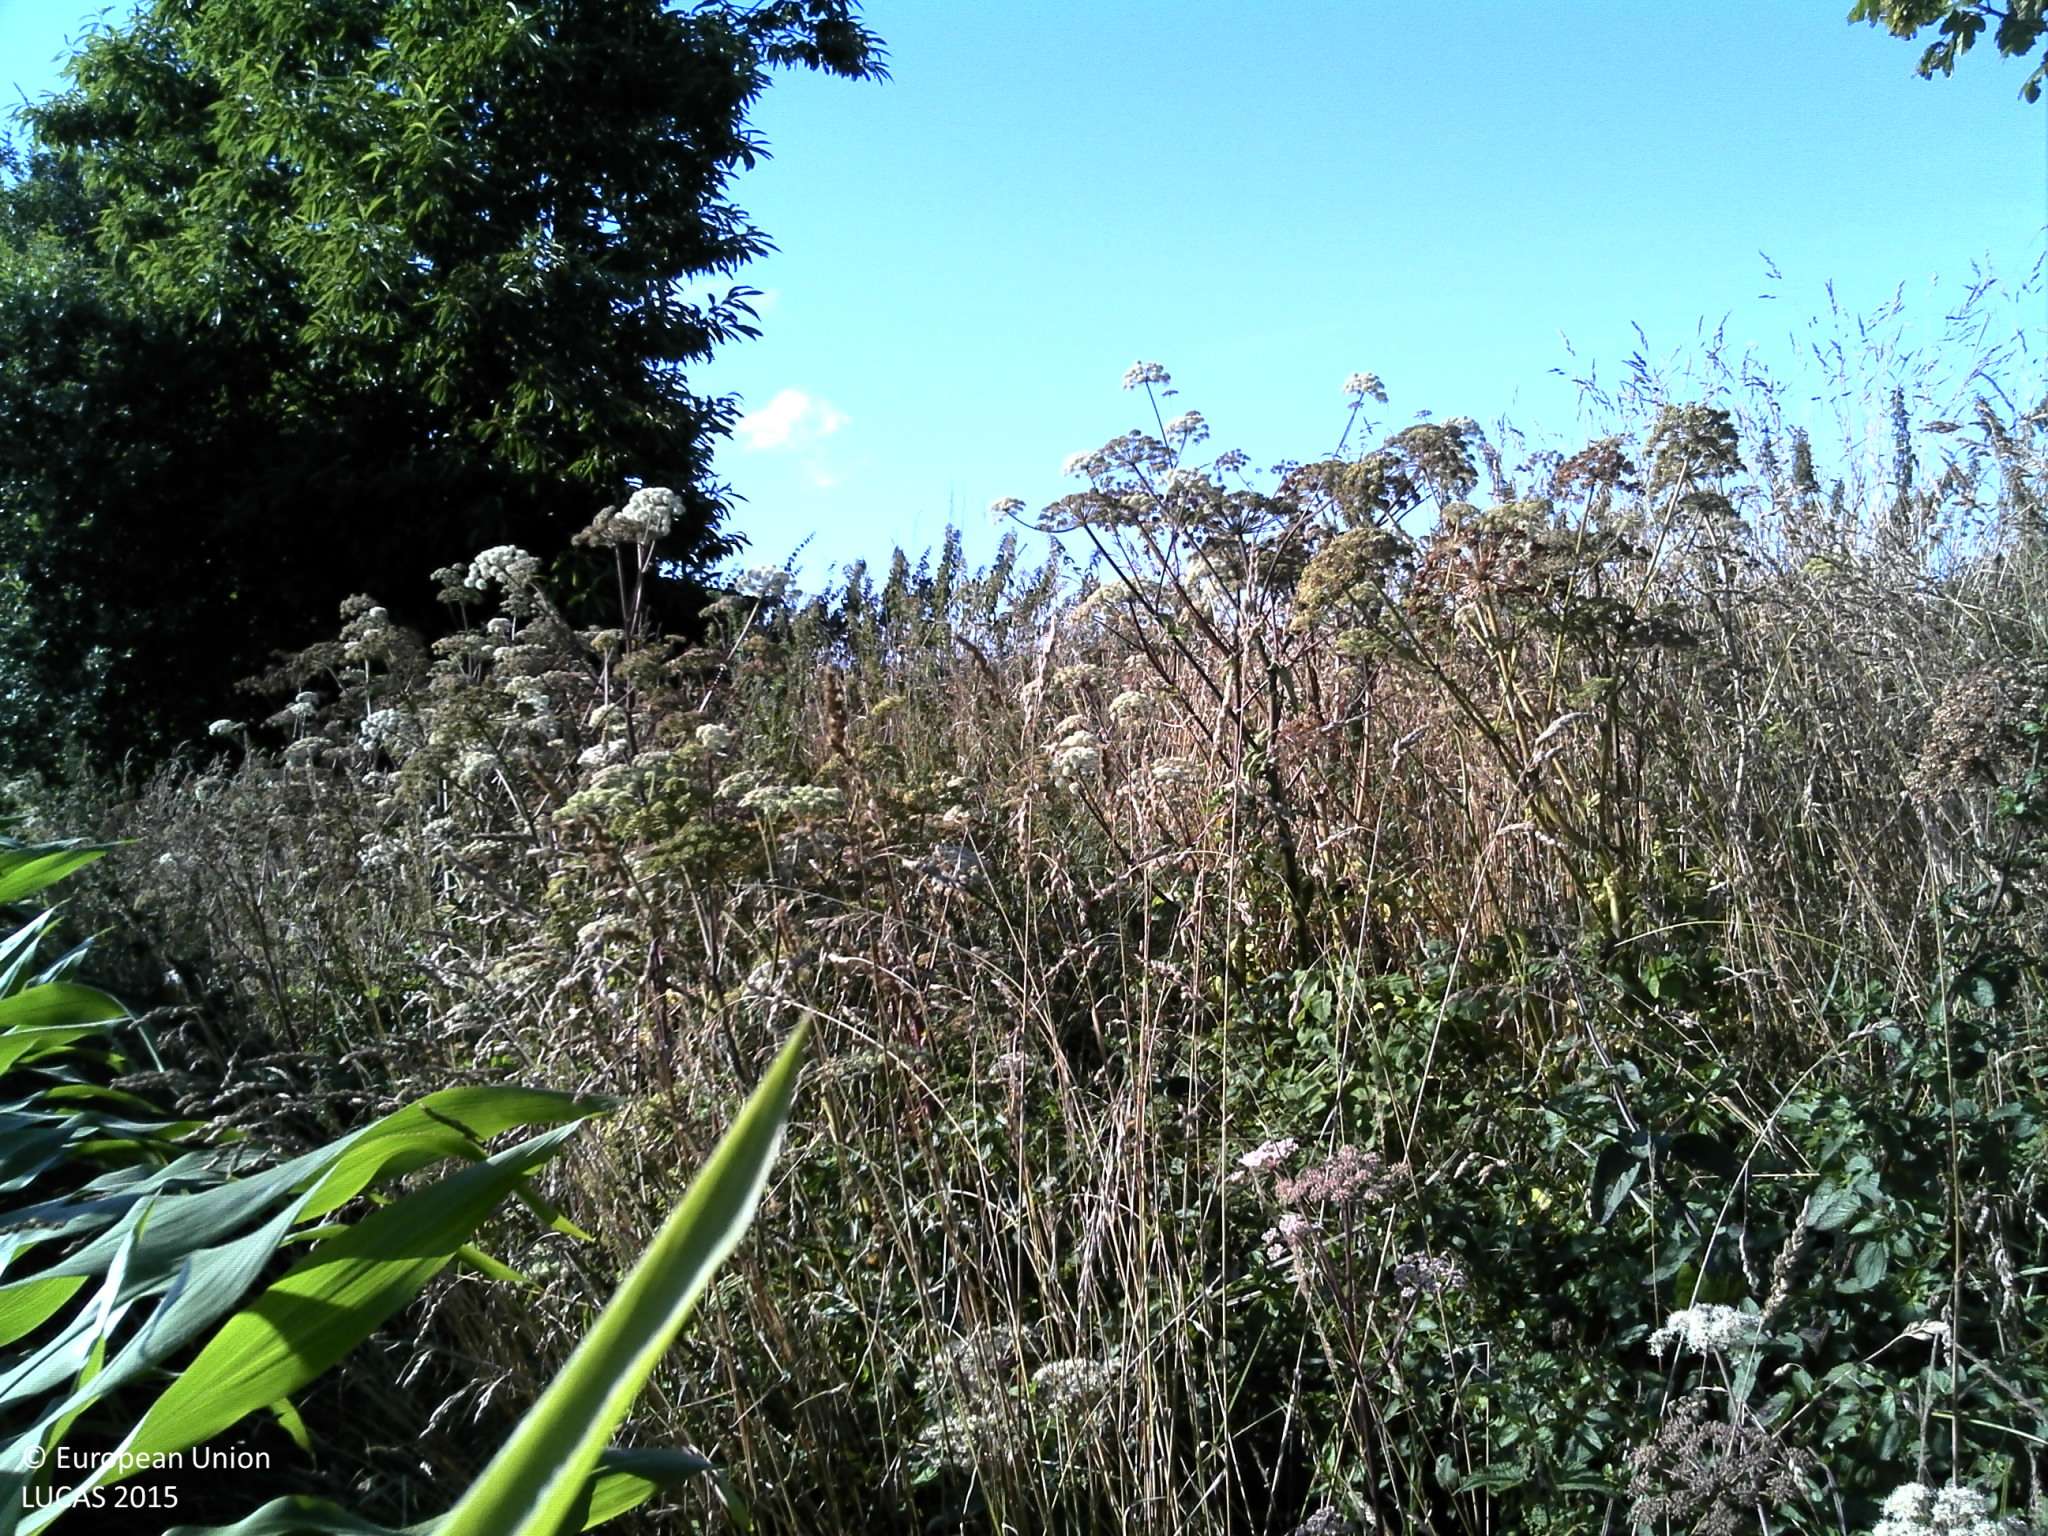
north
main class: Cropland
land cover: Maize
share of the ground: > 75 %
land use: Agriculture (excluding fallow land and kitchen gardens)
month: July
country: FR
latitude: 48.5384
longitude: -4.4964
